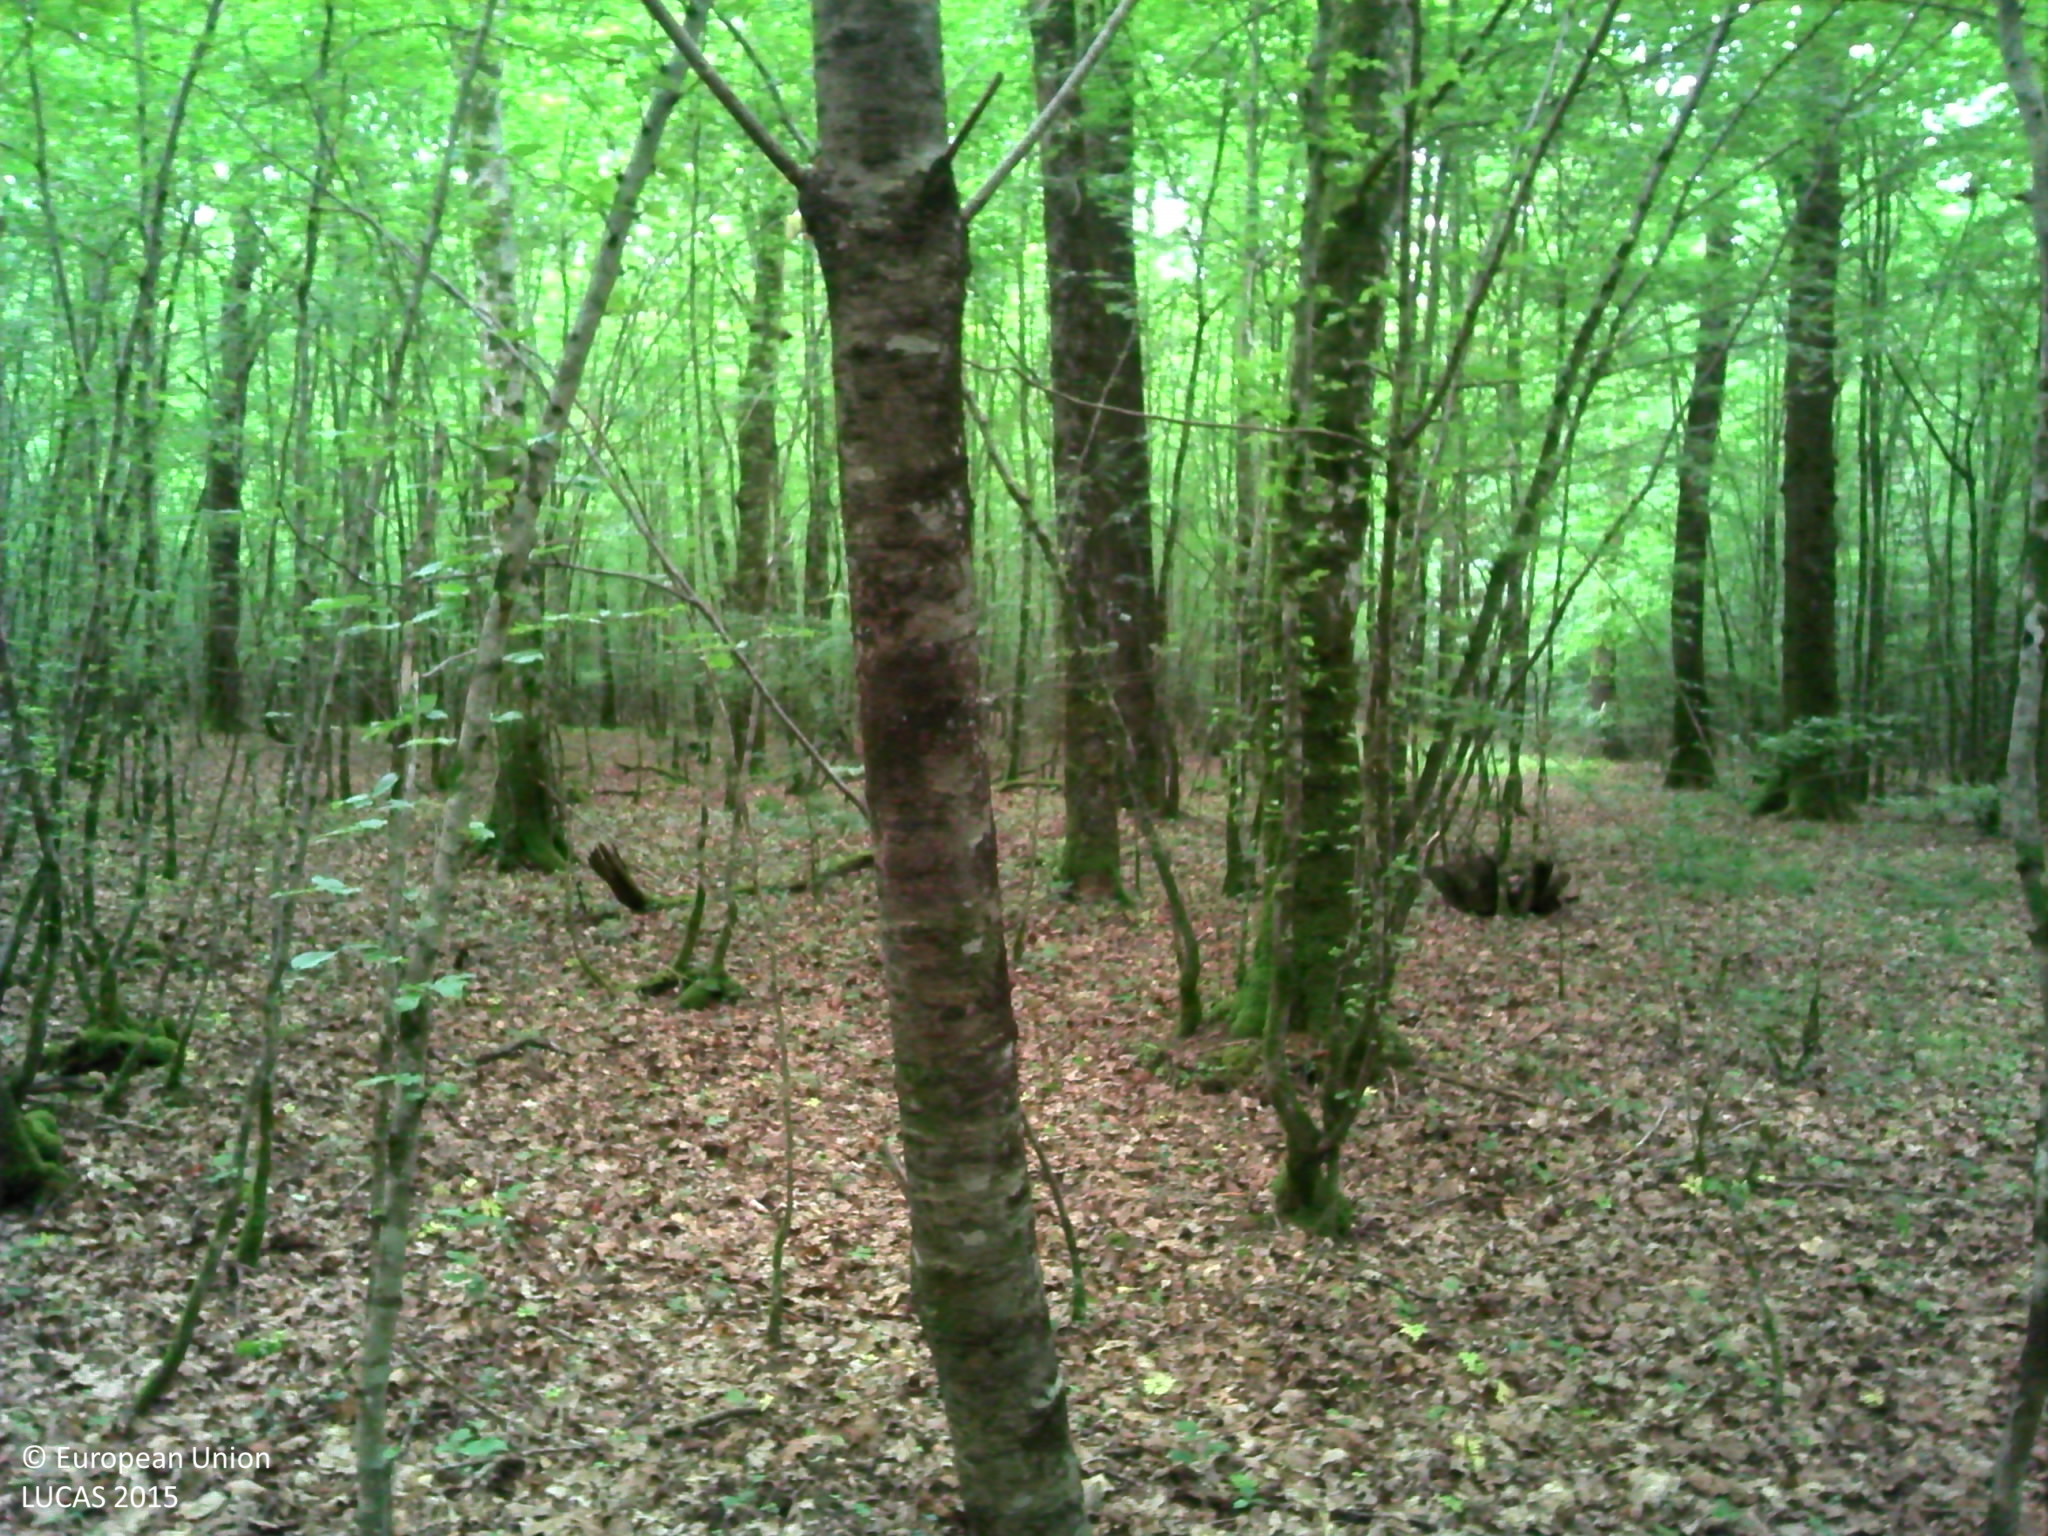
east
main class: Woodland
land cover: Broadleaved woodland
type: mesophytic deciduous forest
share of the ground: > 75 %
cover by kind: broadleaved forest trees 90 %, herbaceous plants 10 %
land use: Forestry
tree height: > 5 m
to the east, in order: Broadleaved woodland; Tracks; Broadleaved woodland
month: June
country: FR
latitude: 48.5404
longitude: 4.9462
